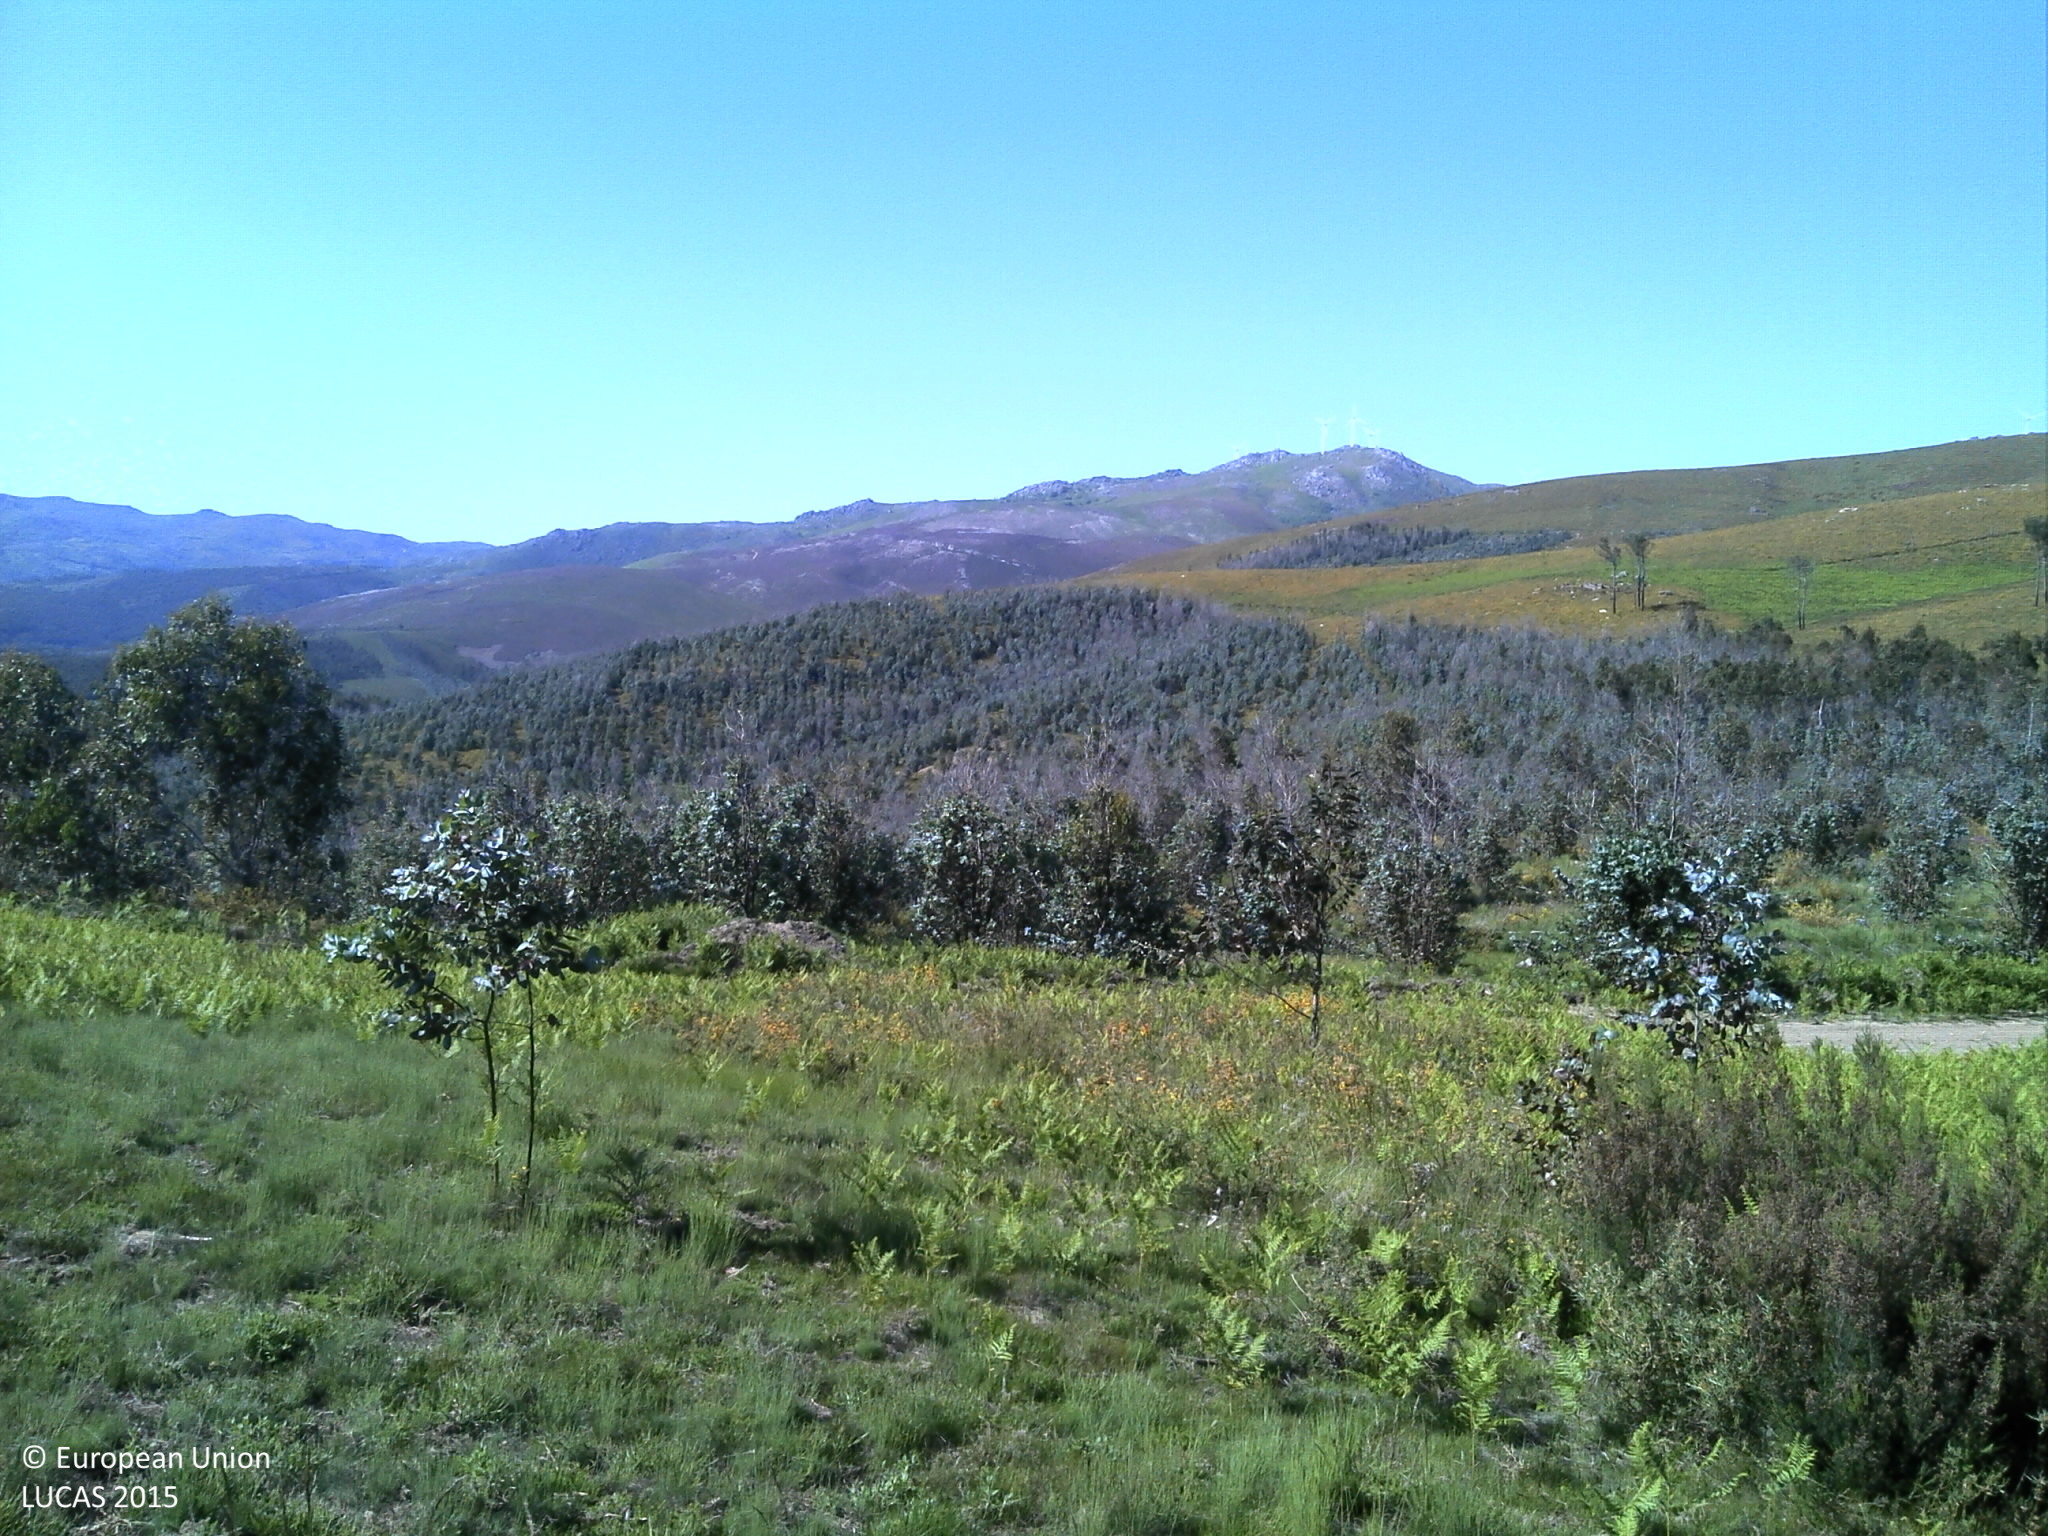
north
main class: Grassland
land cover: Grassland without tree/shrub cover
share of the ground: > 75 %
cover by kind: herbaceous plants 90 %, unconsolidated bare surface 10 %
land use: Agriculture (excluding fallow land and kitchen gardens)
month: May
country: PT
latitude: 40.9677
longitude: -8.1137
